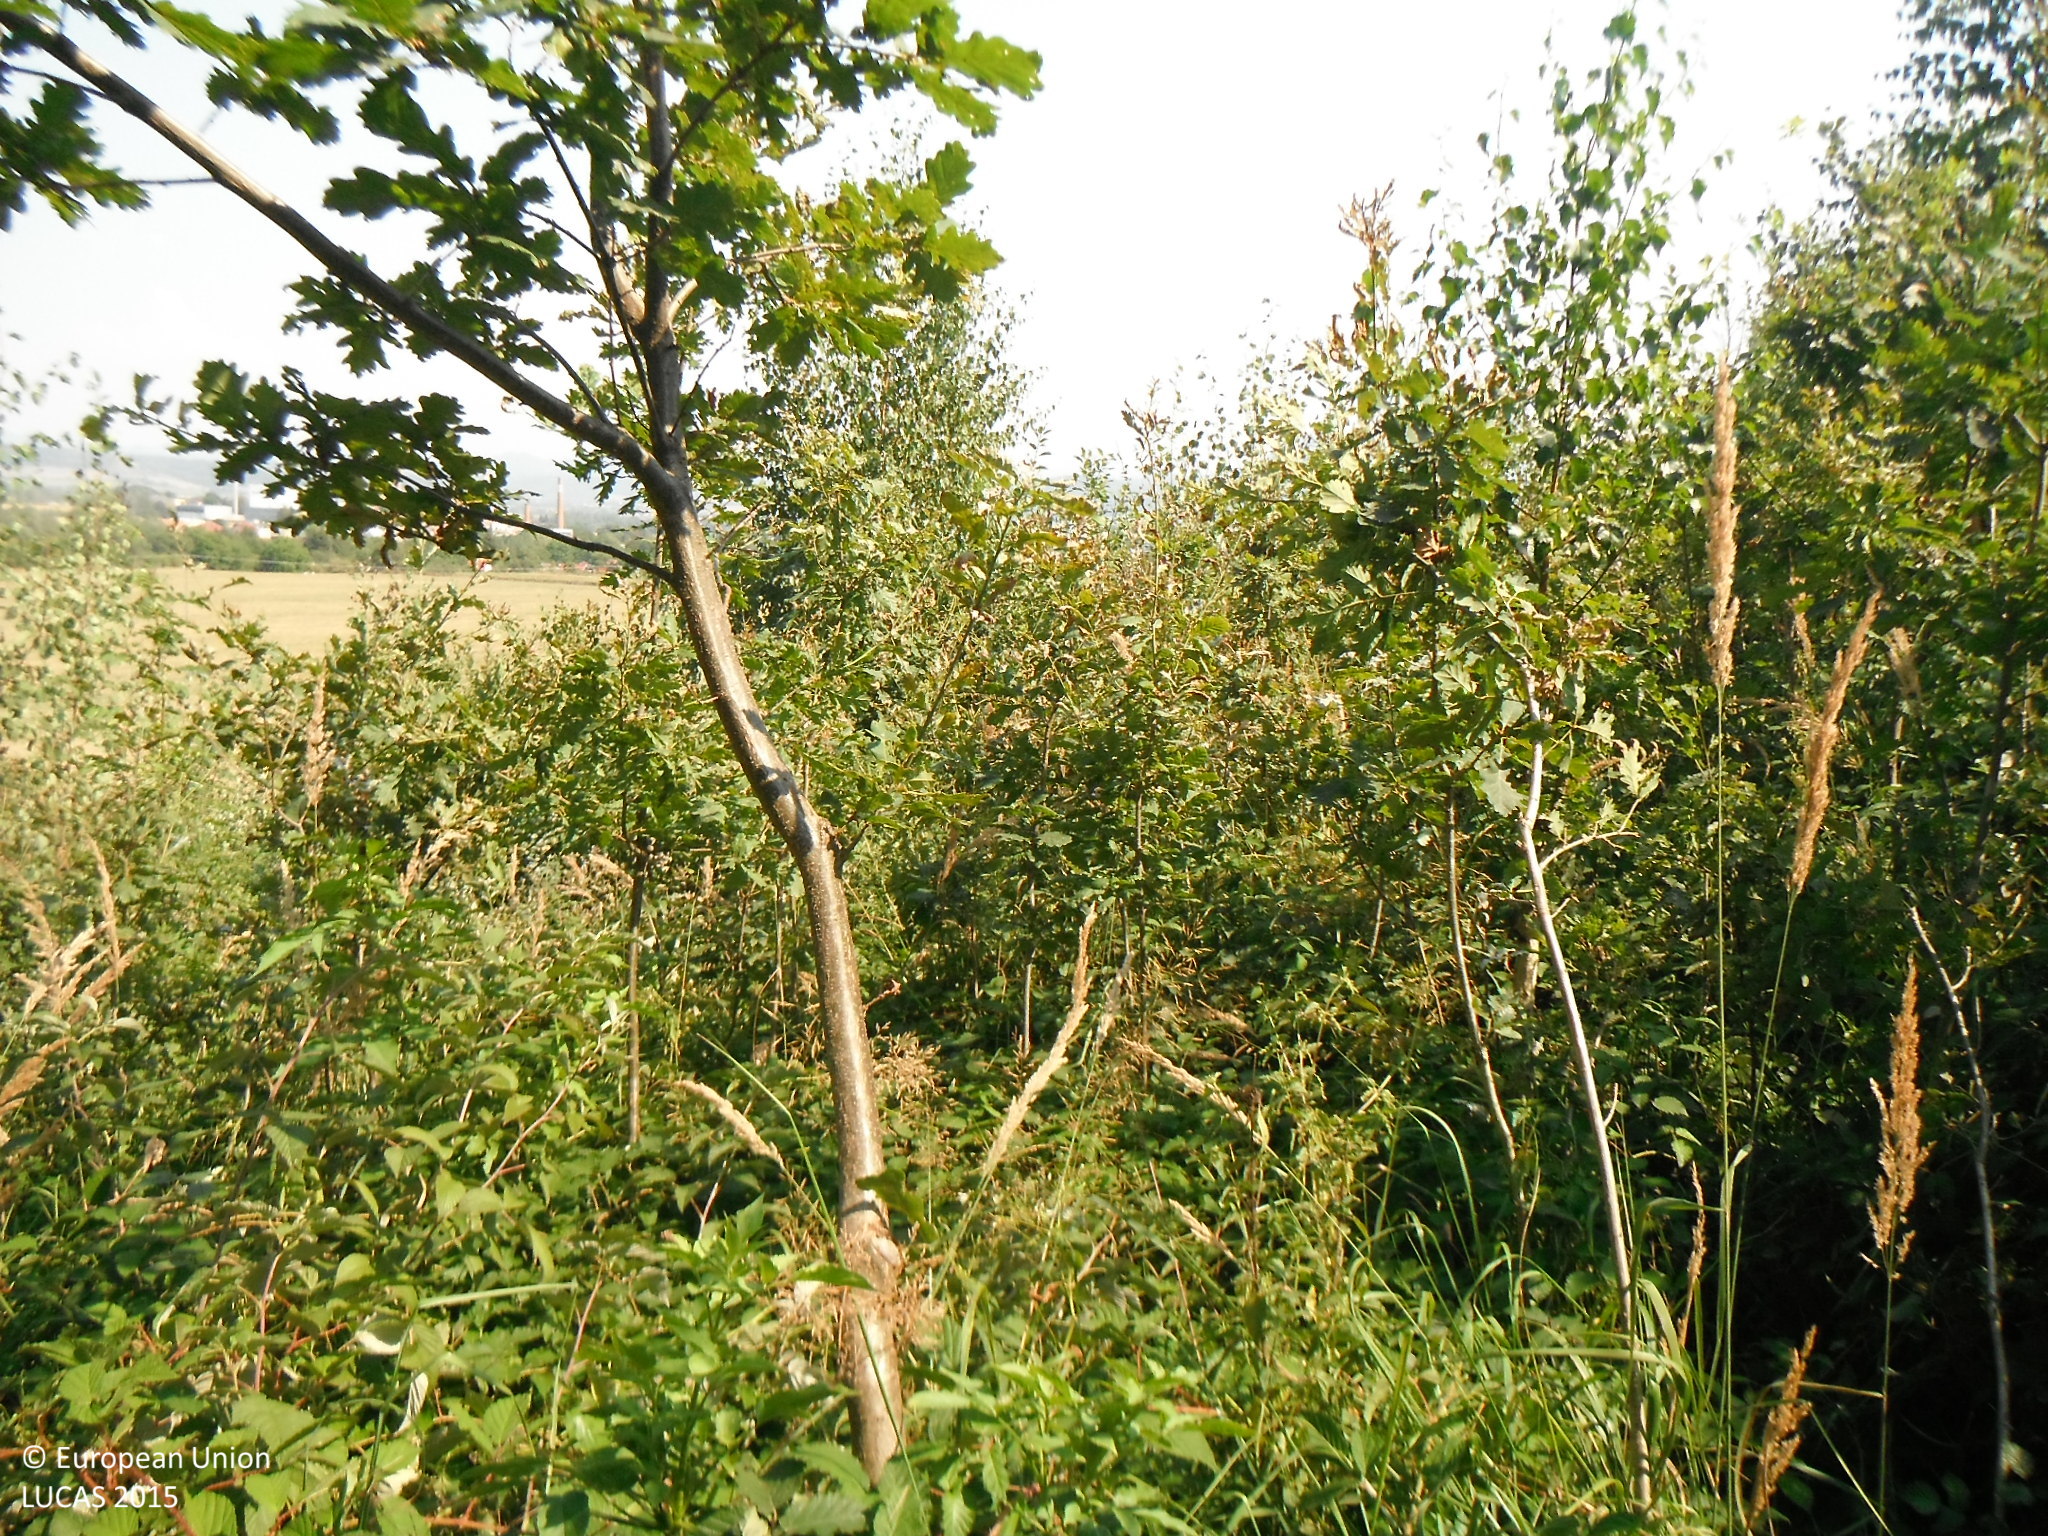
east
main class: Woodland
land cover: Broadleaved woodland
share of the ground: > 75 %
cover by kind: broadleaved forest trees 60 %, shrubs 35 %, herbaceous plants 5 %
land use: Forestry
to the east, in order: Broadleaved woodland; Grass margins; Tracks; Grass margins; Common wheat
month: August
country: SK
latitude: 49.0699
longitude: 18.2702
